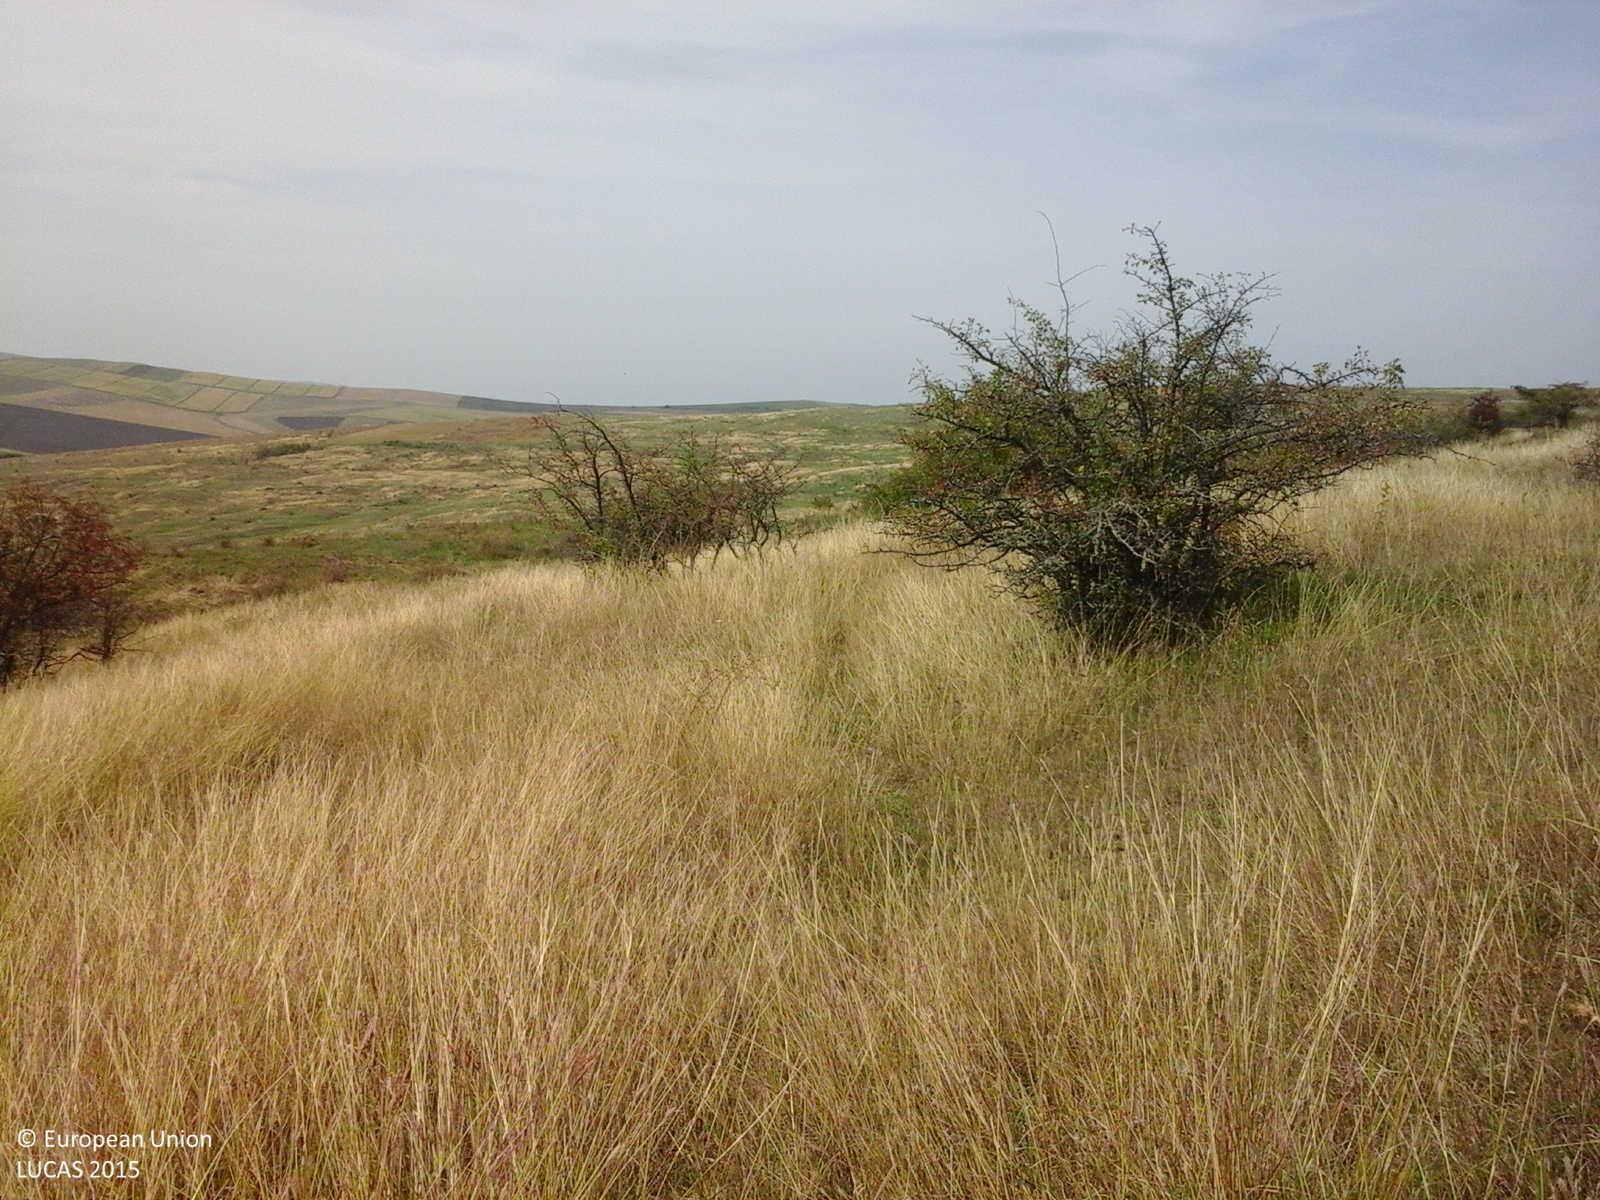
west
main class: Grassland
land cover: Grassland with sparse tree/shrub cover
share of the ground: > 75 %
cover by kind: herbaceous plants 85 %, shrubs 10 %, broadleaved forest trees 5 %
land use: Agriculture (excluding fallow land and kitchen gardens)
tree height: < 5 m
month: September
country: RO
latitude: 46.9084
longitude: 23.6882
